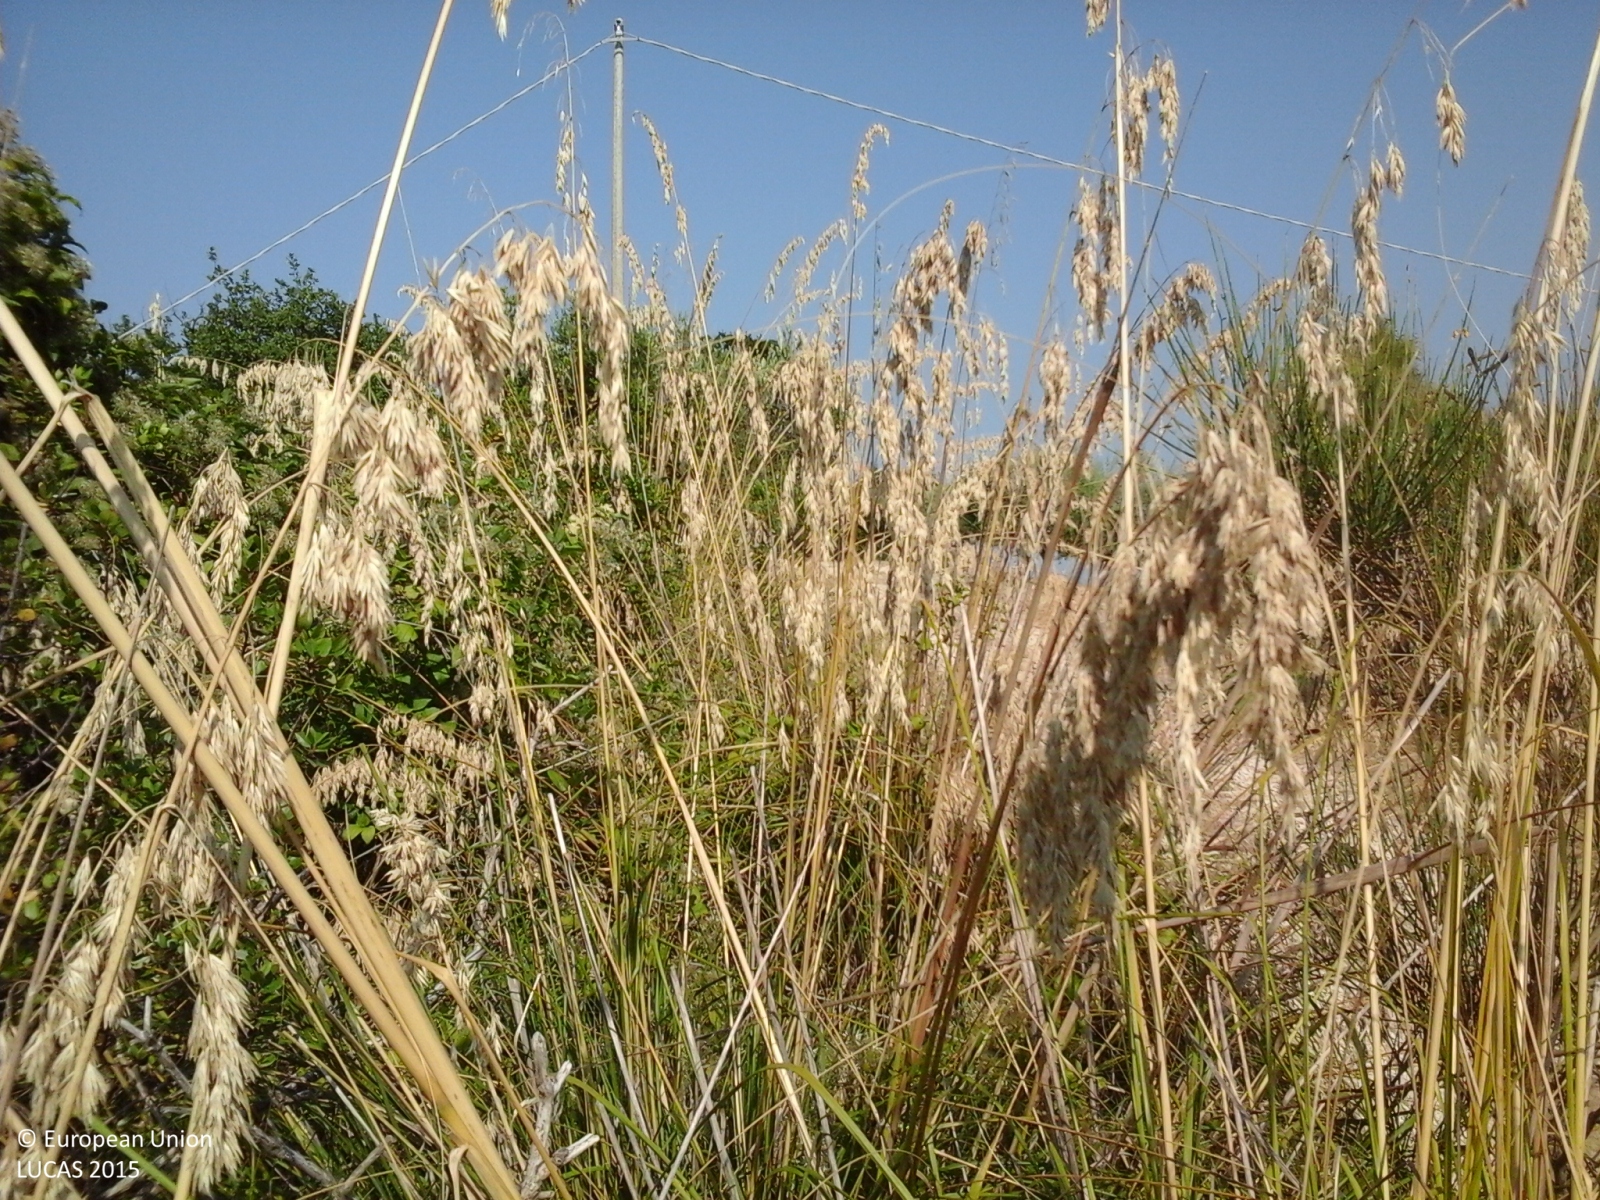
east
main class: Shrubland
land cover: Shrubland without tree cover
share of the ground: 50 - 75 %
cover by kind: shrubs 95 %, herbaceous plants 5 %
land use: Semi-natural and natural areas not in use
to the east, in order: Shrubland without tree cover; Olive groves; Electric lines; Olive groves; Broadleaved woodland; Artificial constructions in urban areas; Grassland without tree/shrub cover; Tracks; Grassland without tree/shrub cover; Lines of trees; Grassland without tree/shrub cover; Broadleaved woodland; Shrubland with sparse tree cover
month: July
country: IT
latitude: 43.1065
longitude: 13.8116
